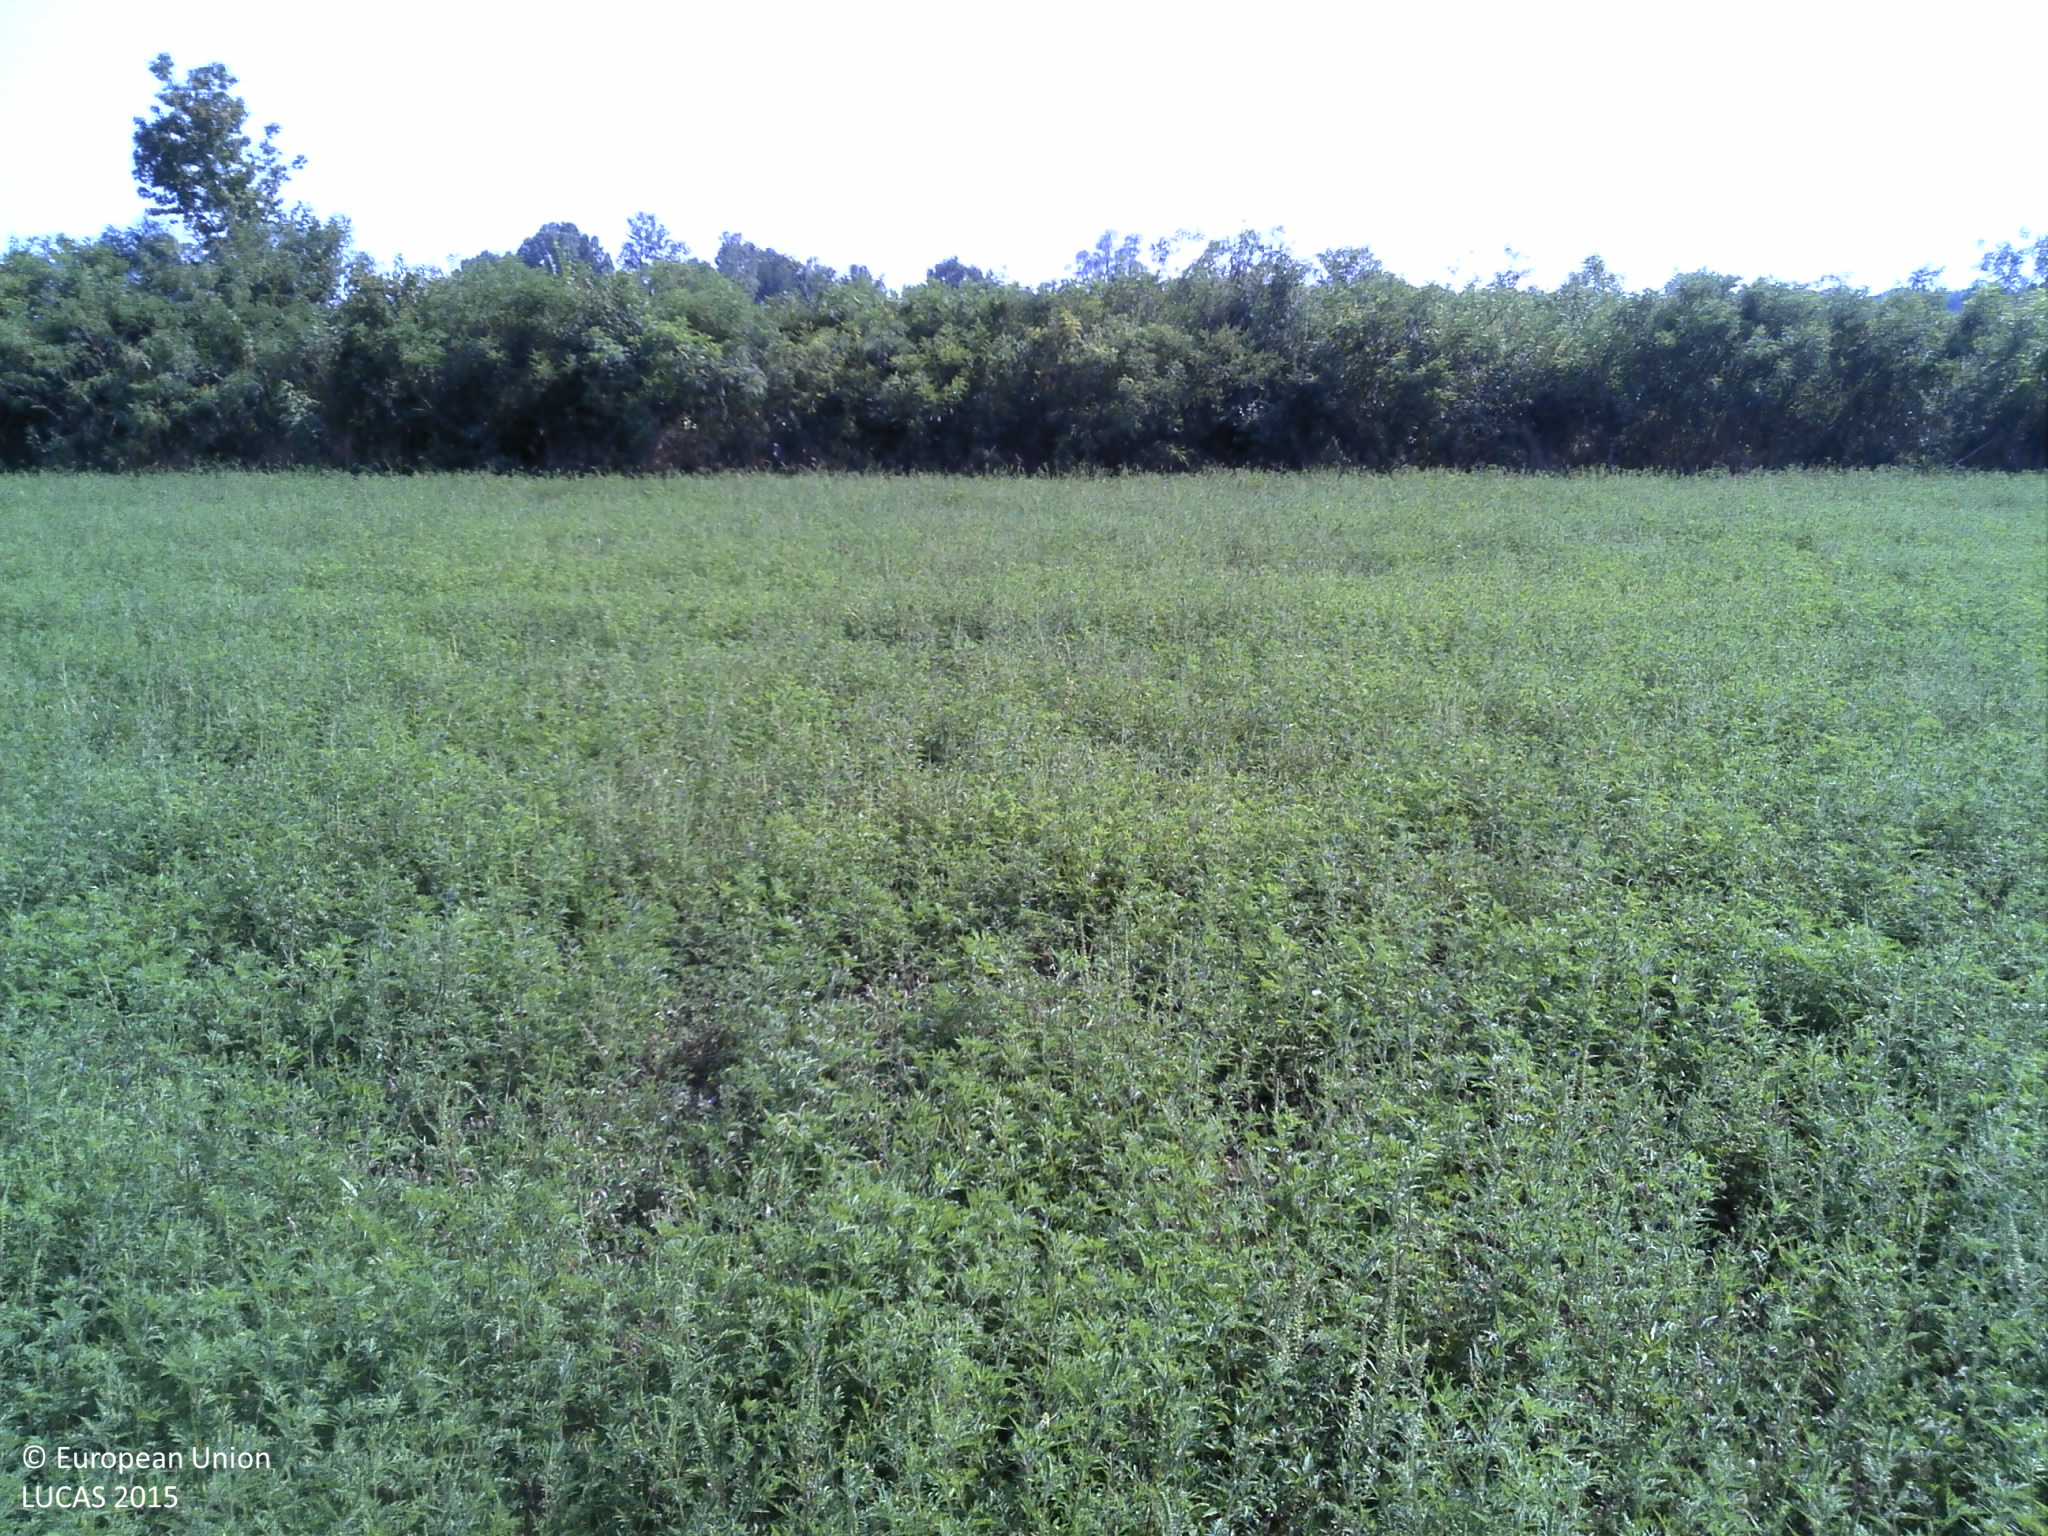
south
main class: Grassland
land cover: Spontaneously vegetated surfaces
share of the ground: > 75 %
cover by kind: herbaceous plants 100 %
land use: Fallow land
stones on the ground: < 10 %
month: August
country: HR
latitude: 45.2064
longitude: 17.1671
